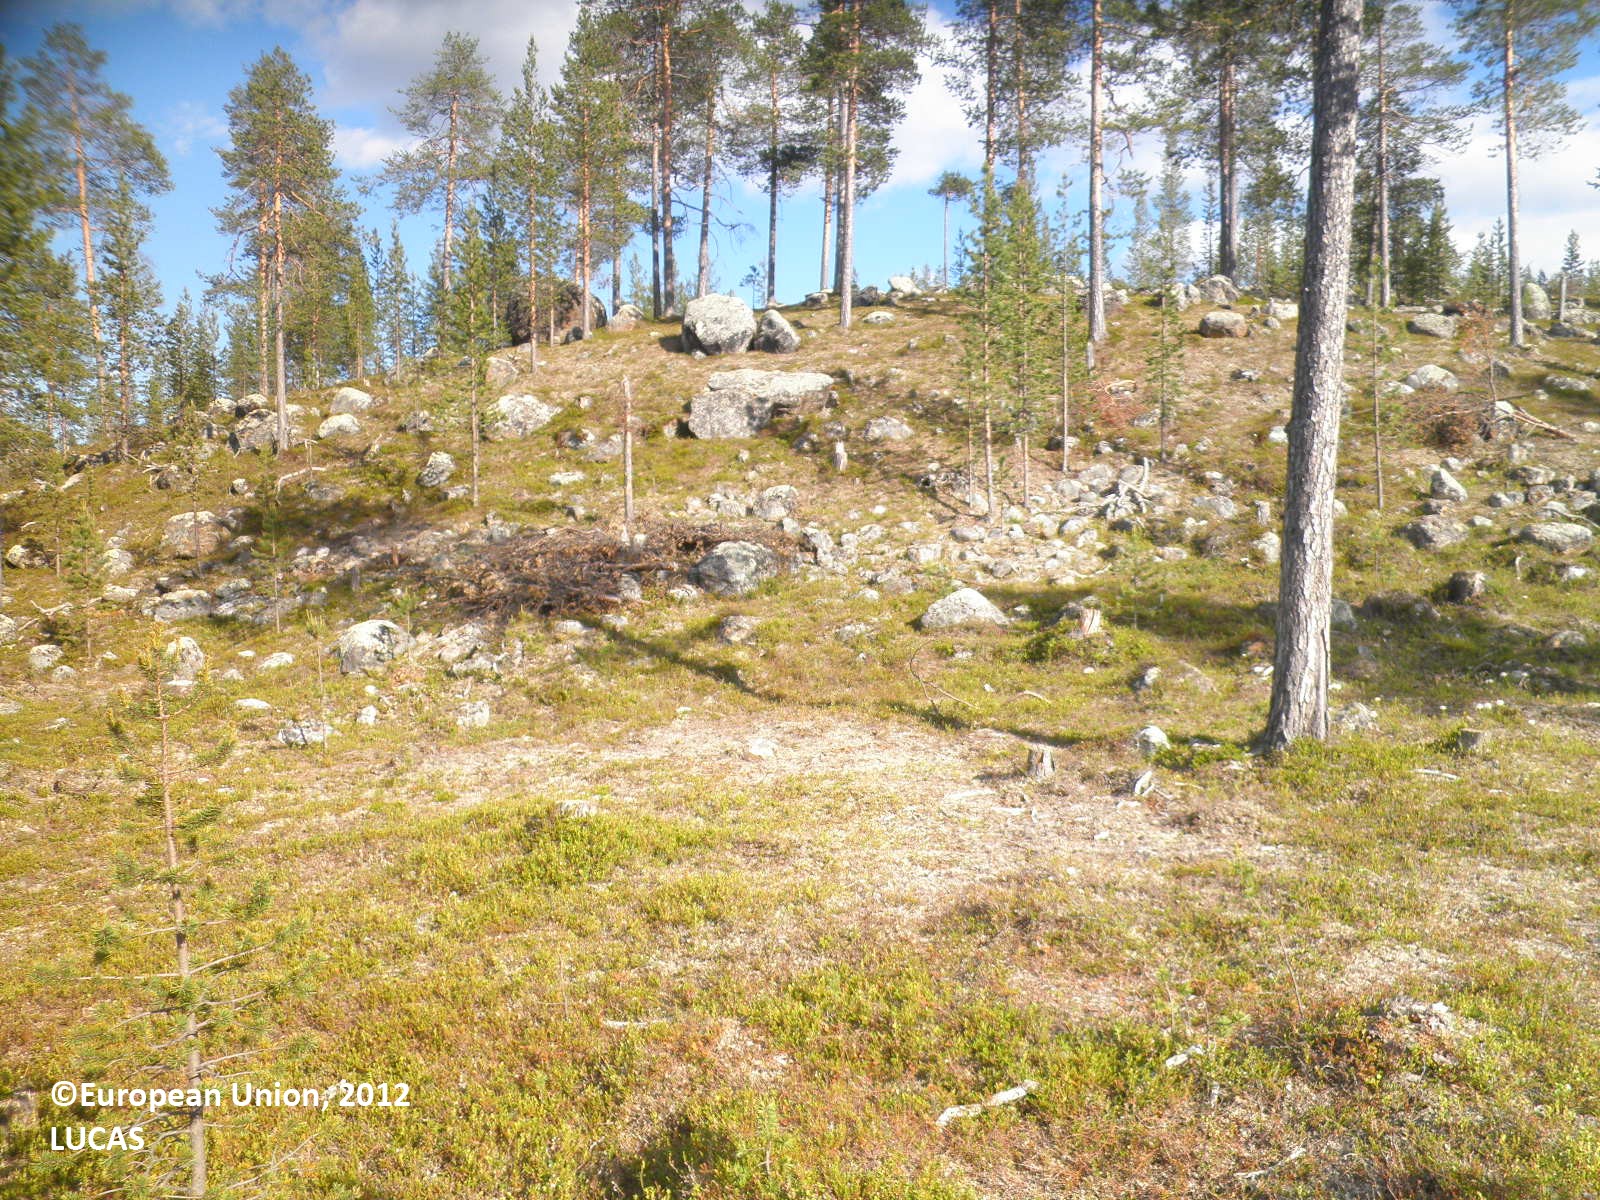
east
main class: Woodland
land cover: Pine dominated coniferous woodland
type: boreal forest
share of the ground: 10 - 25 %
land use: Forestry
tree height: > 5 m
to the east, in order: Pine dominated coniferous woodland; Pine dominated mixed woodland; Ponds and wetlands; Pine dominated mixed woodland; Rivers and streams; Pine dominated mixed woodland
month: July
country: FI
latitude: 68.8843
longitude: 27.1003
